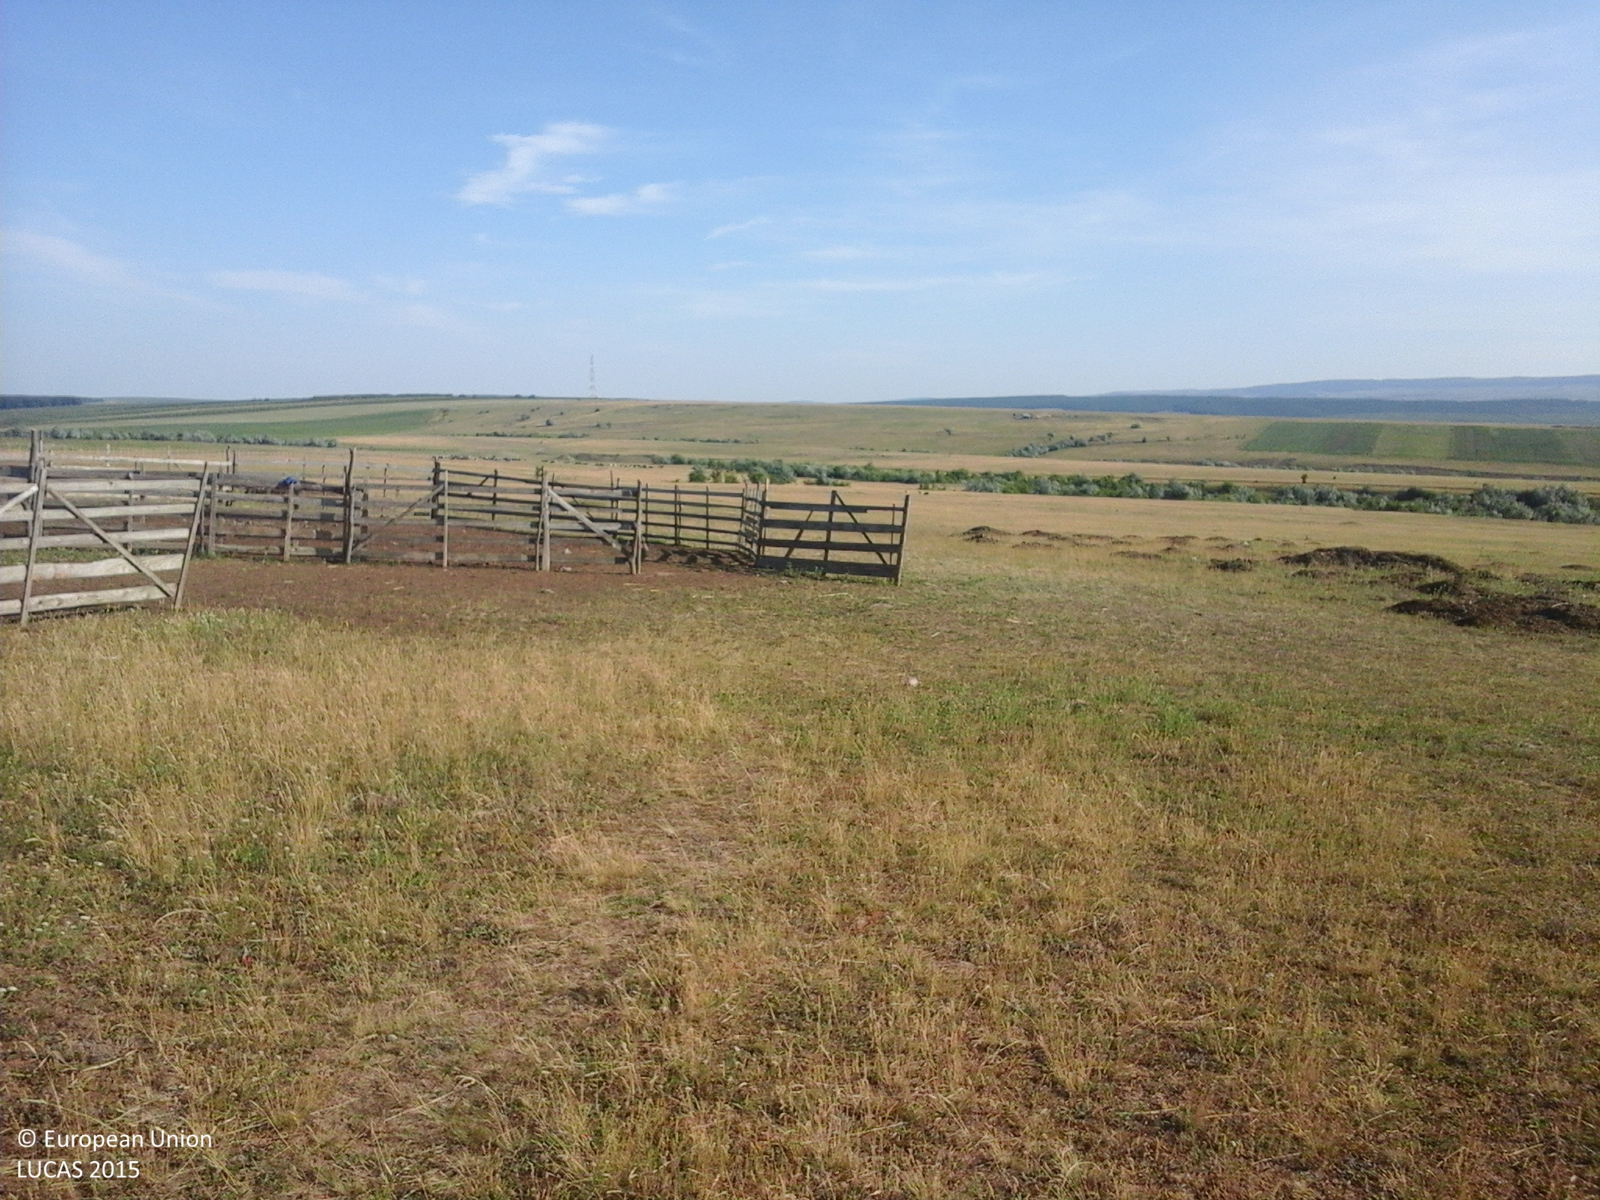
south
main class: Grassland
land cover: Grassland without tree/shrub cover
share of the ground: 25 - 50 %
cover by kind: unconsolidated bare surface 60 %, herbaceous plants 40 %
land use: Agriculture (excluding fallow land and kitchen gardens)
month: June
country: RO
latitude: 47.6702
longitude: 26.9503
